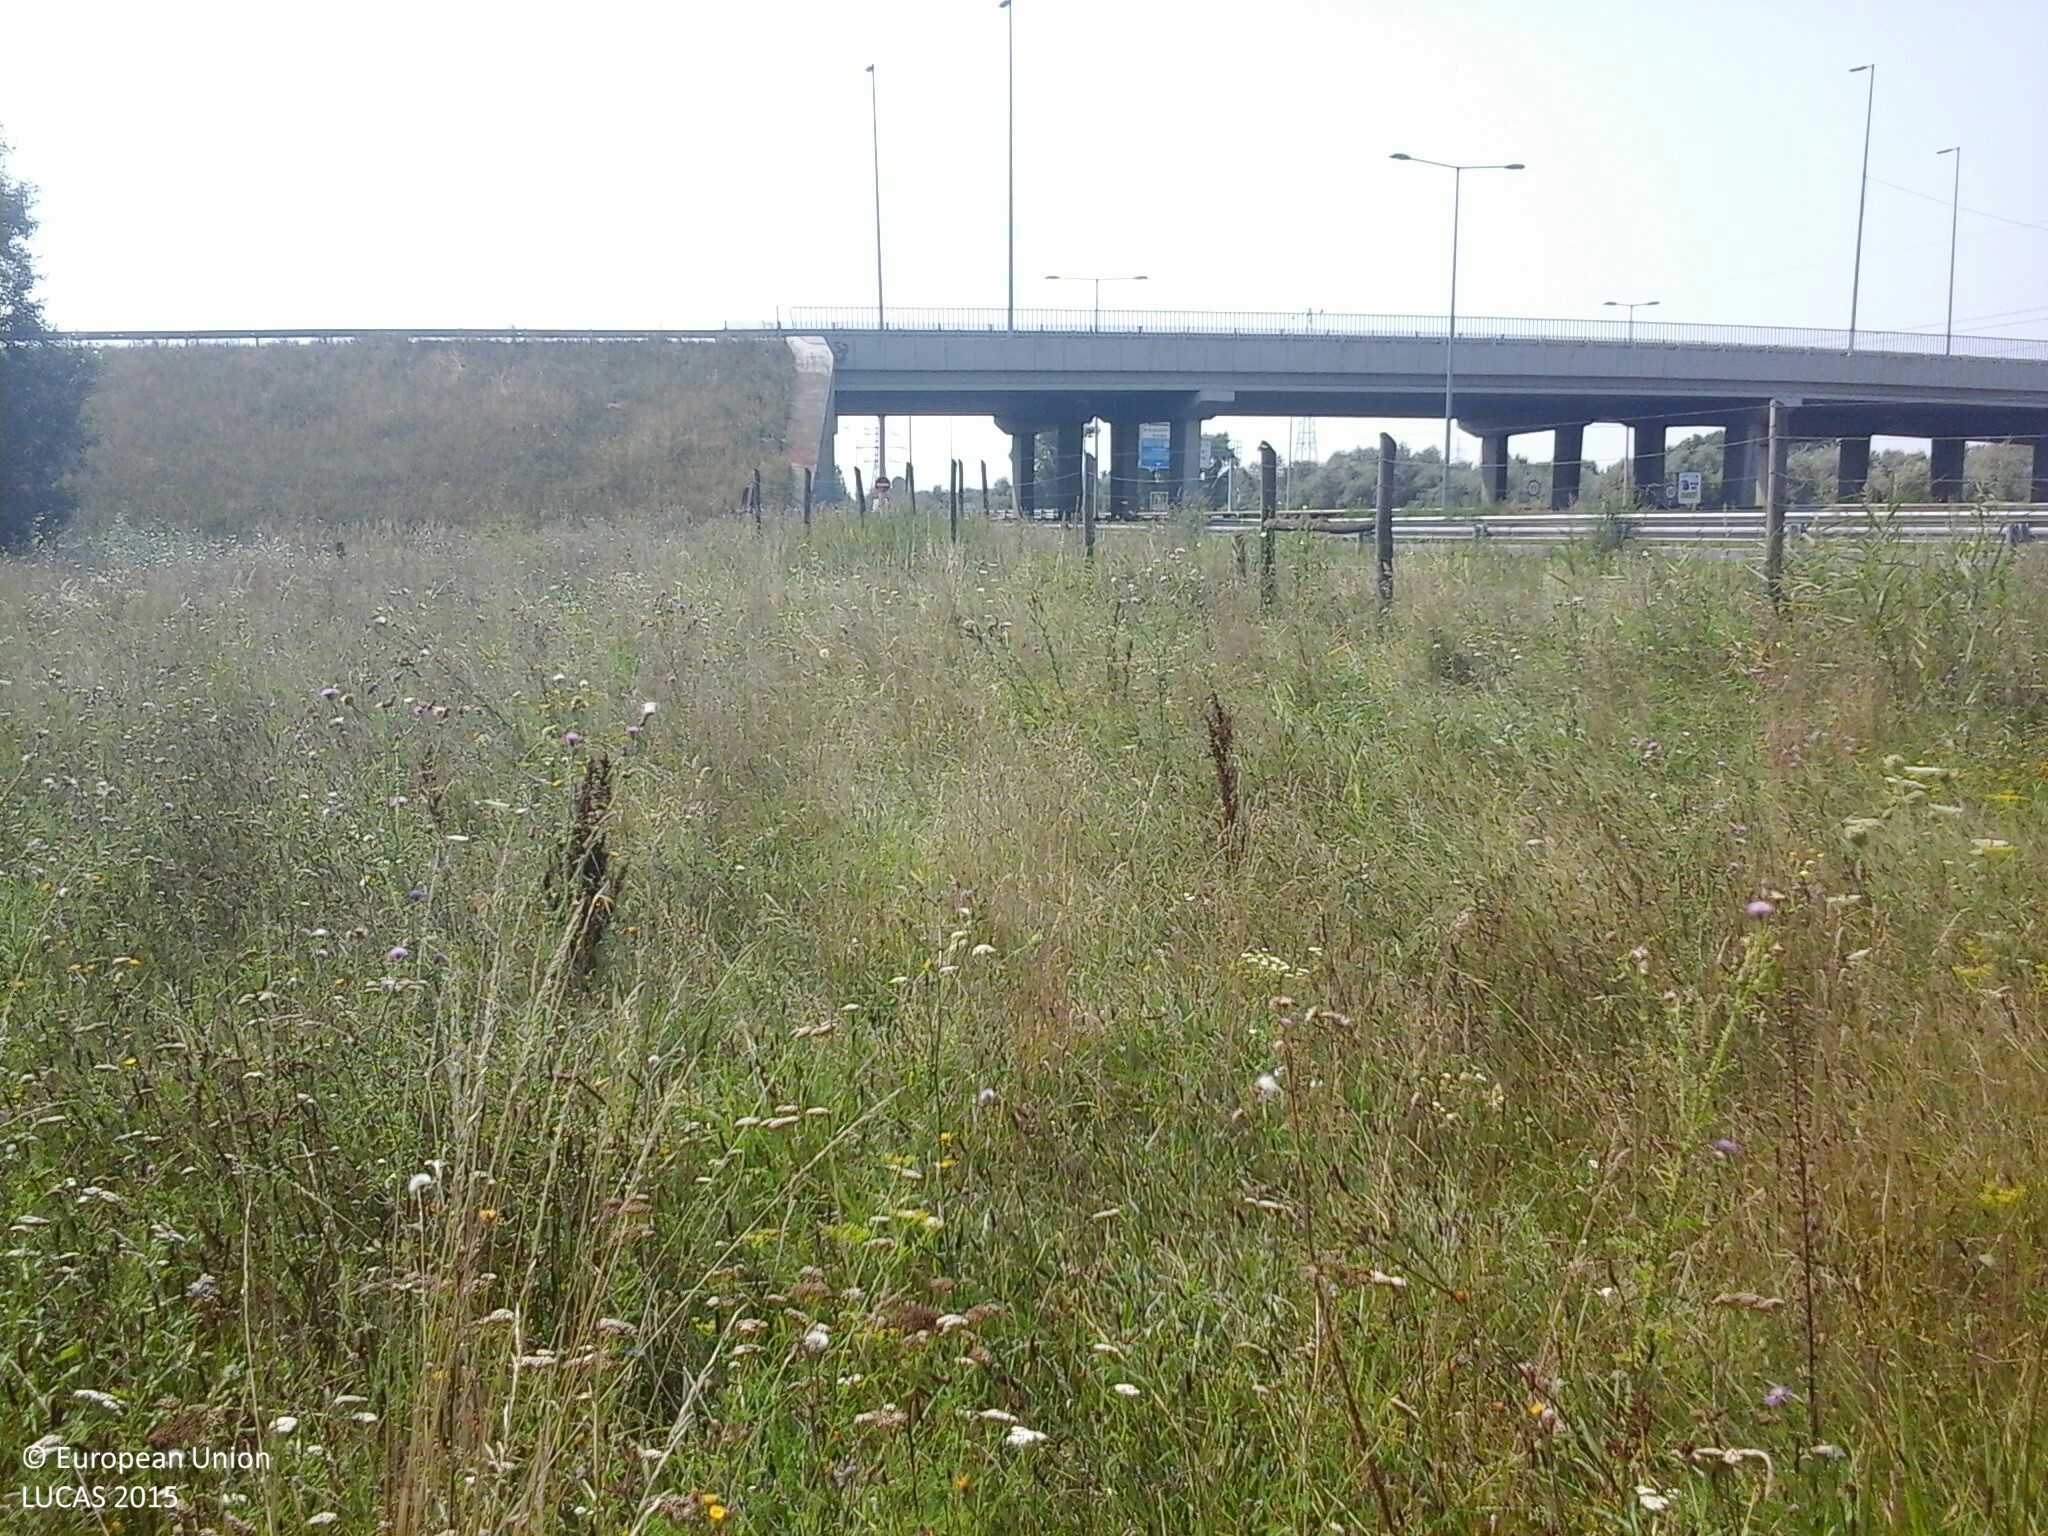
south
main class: Grassland
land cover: Grassland without tree/shrub cover
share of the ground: > 75 %
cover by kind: herbaceous plants 100 %
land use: Road transport
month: August
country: HU
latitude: 47.4256
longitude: 19.1521
